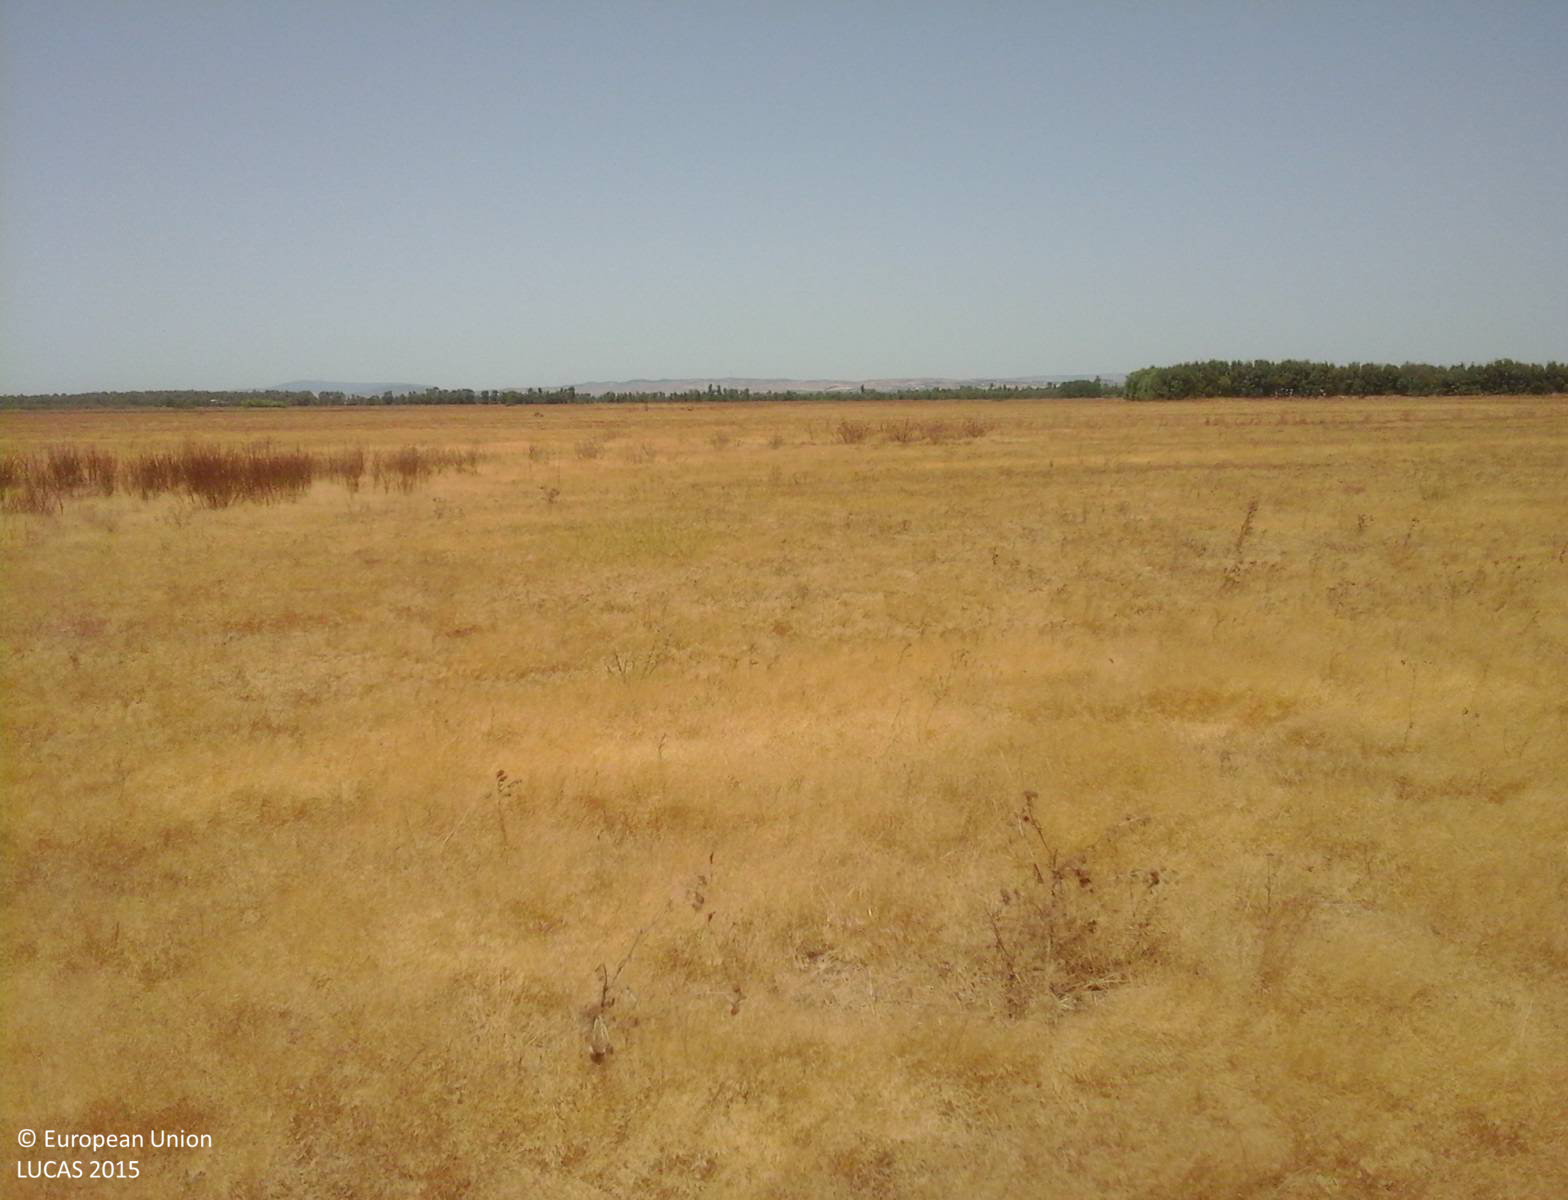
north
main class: Cropland
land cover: Mixed cereals for fodder
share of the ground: > 75 %
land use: Agriculture (excluding fallow land and kitchen gardens)
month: August
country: IT
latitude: 39.4459
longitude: 8.8796
